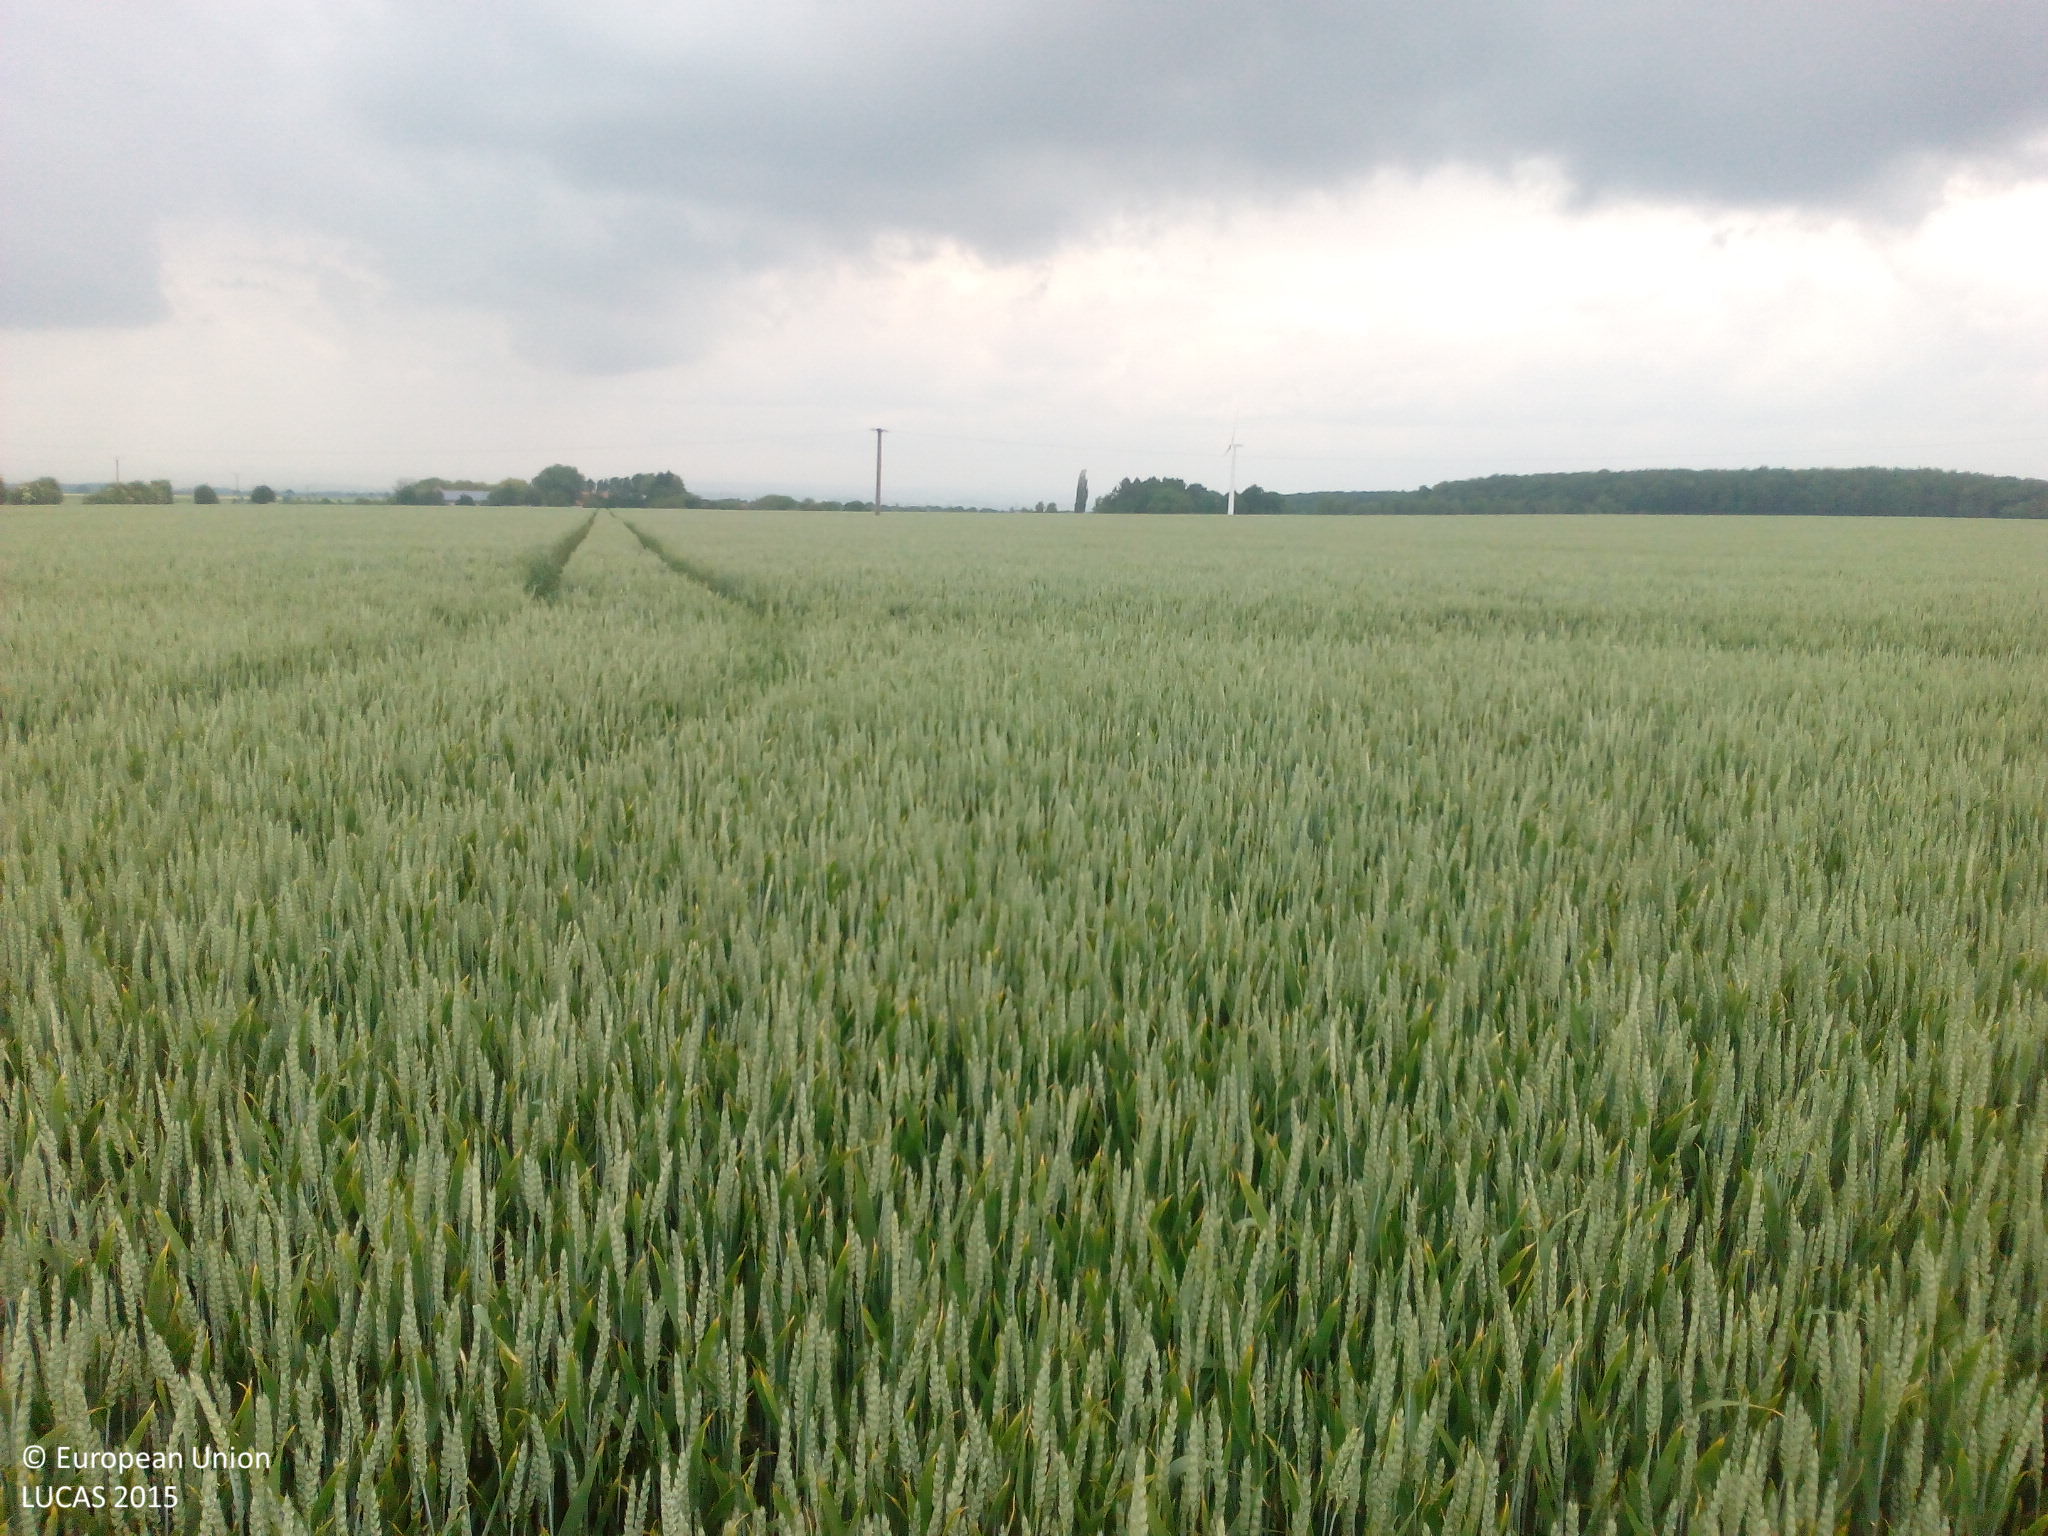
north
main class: Cropland
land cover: Common wheat
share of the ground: > 75 %
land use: Agriculture (excluding fallow land and kitchen gardens)
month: June
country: DE
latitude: 51.5401
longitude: 8.4288
